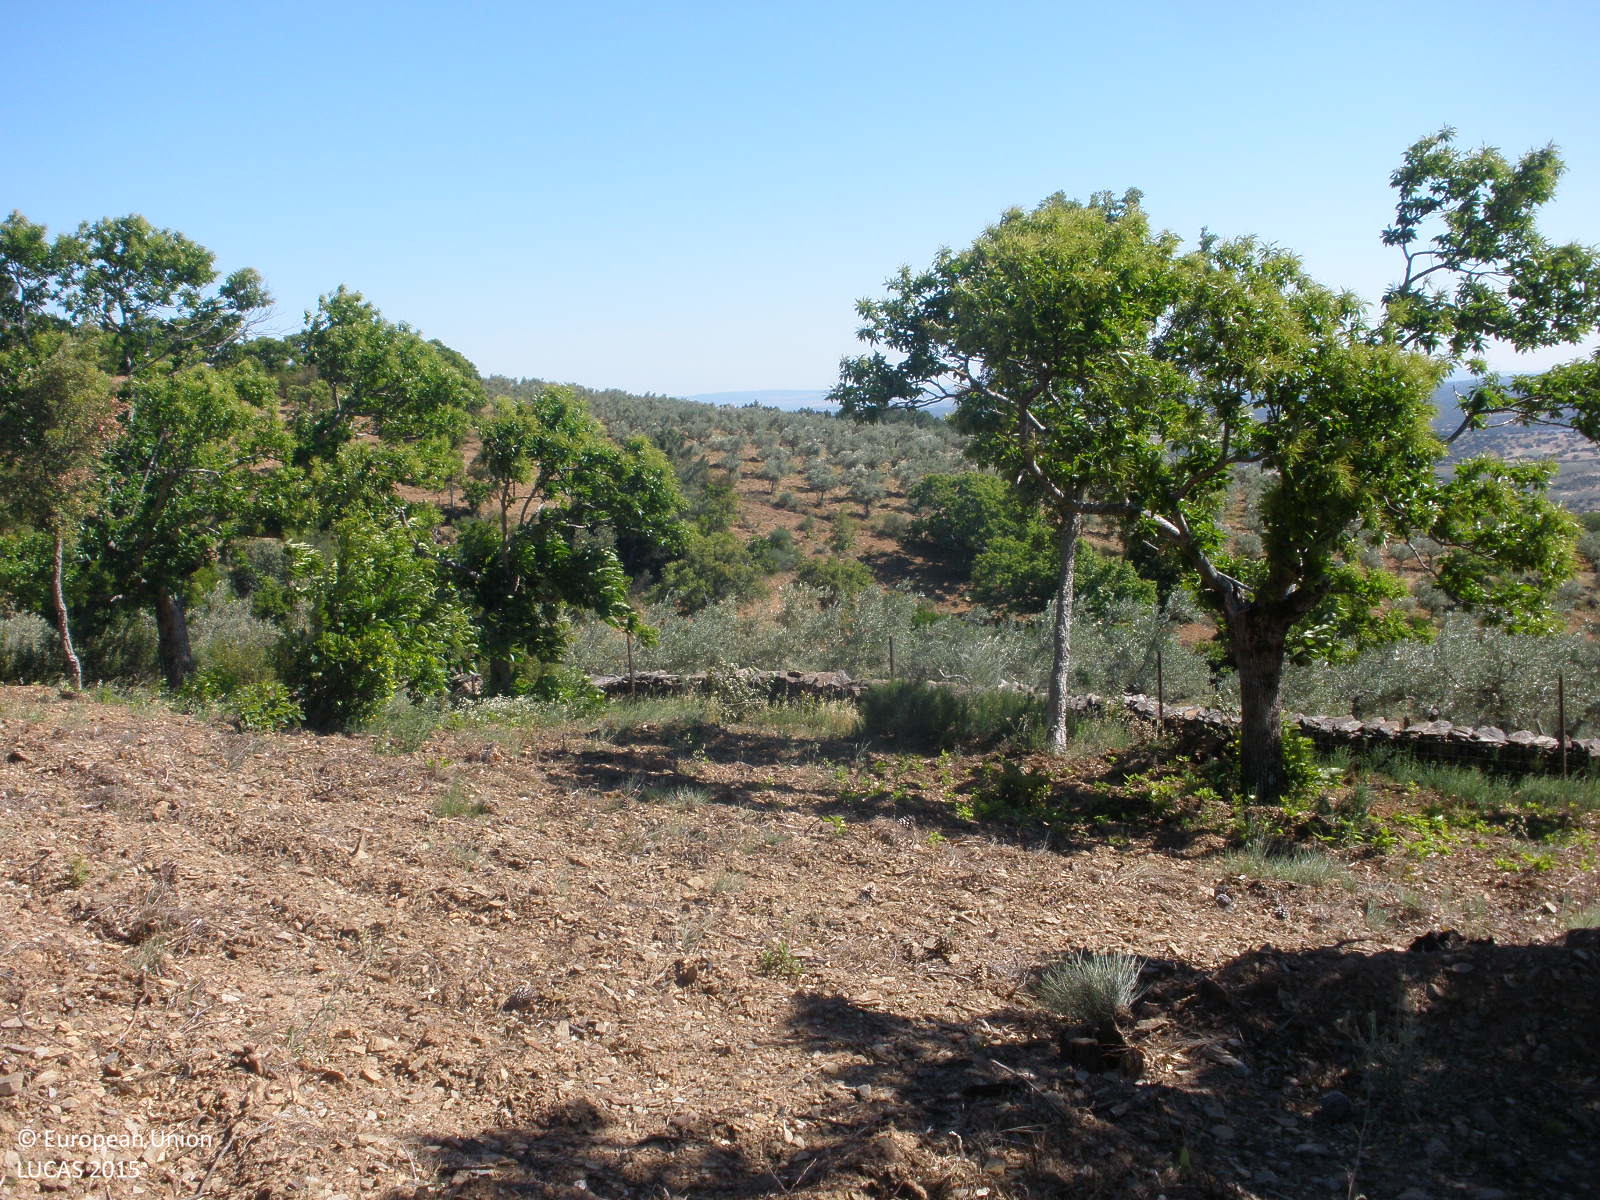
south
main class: Woodland
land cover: Broadleaved woodland
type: broadleaved evergreen forest
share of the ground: > 75 %
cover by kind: herbaceous plants 50 %, broadleaved forest trees 40 %, shrubs 10 %
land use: Forestry
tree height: < 5 m
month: May
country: ES
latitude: 40.2613
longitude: -6.2699
